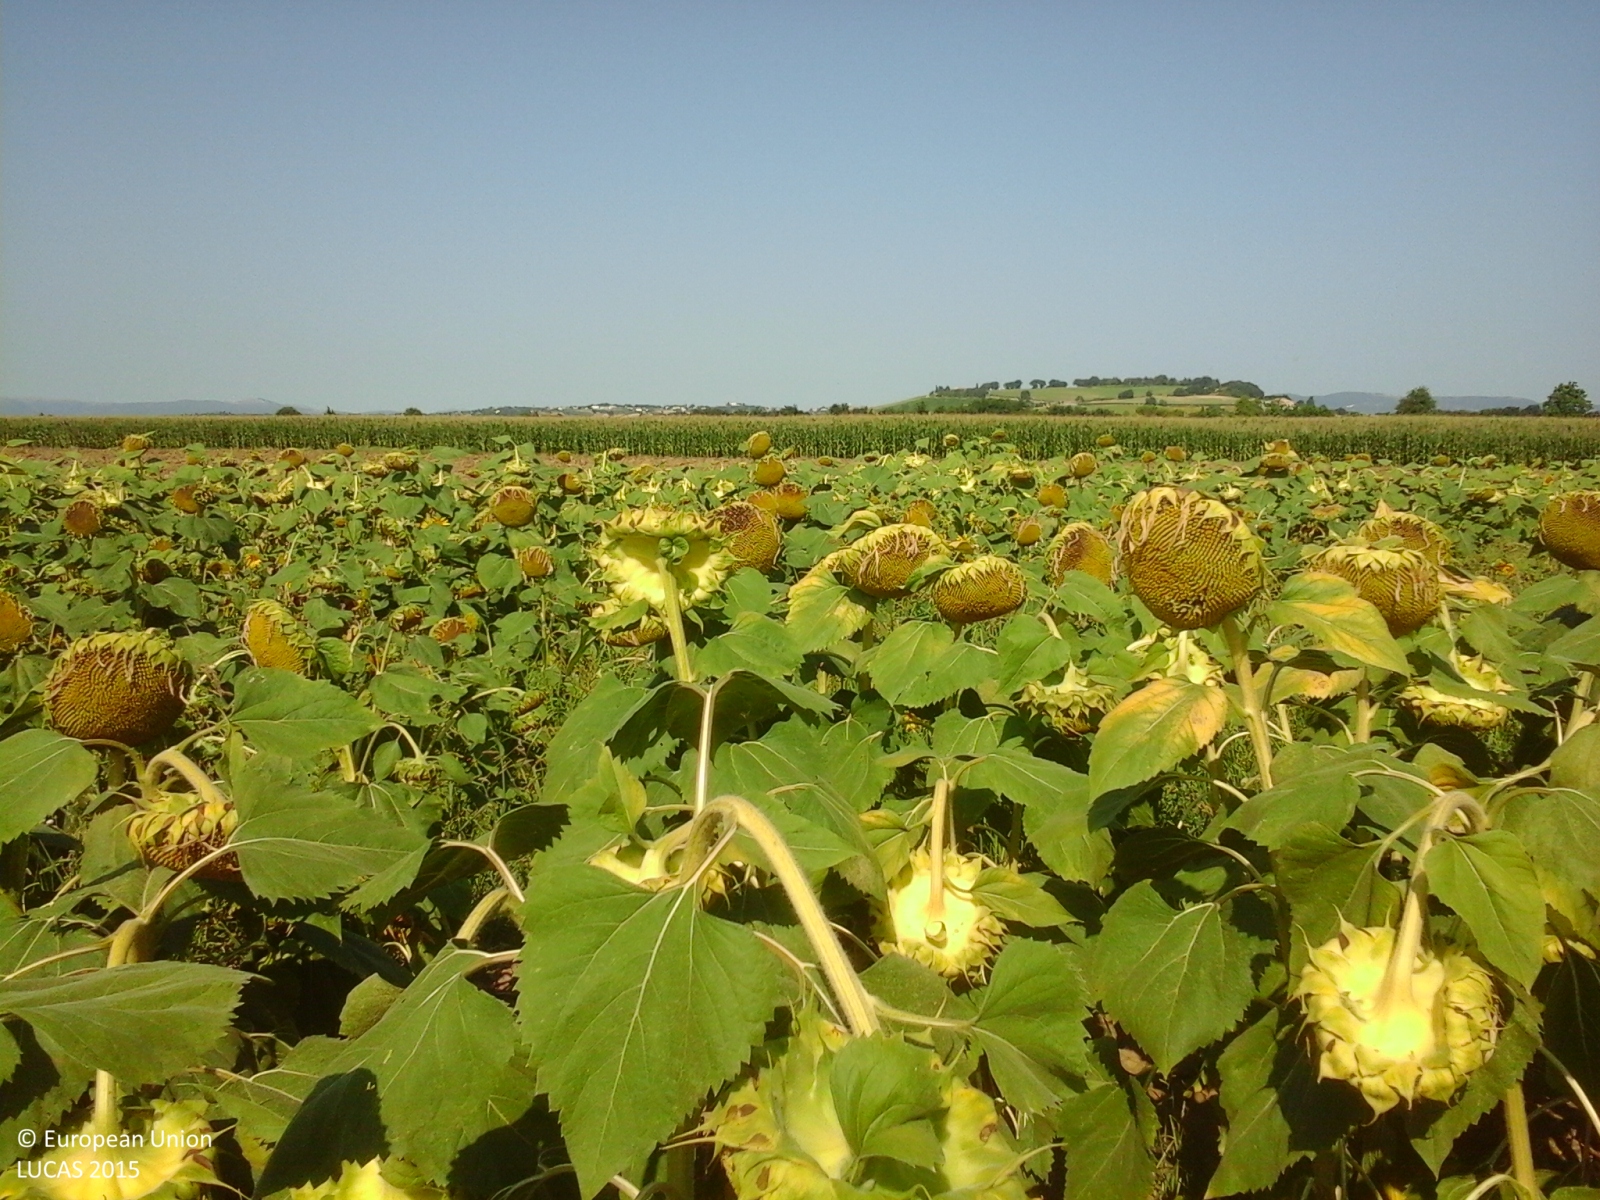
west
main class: Cropland
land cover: Sunflower
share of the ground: > 75 %
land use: Agriculture (excluding fallow land and kitchen gardens)
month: July
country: IT
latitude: 43.2646
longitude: 13.4283
